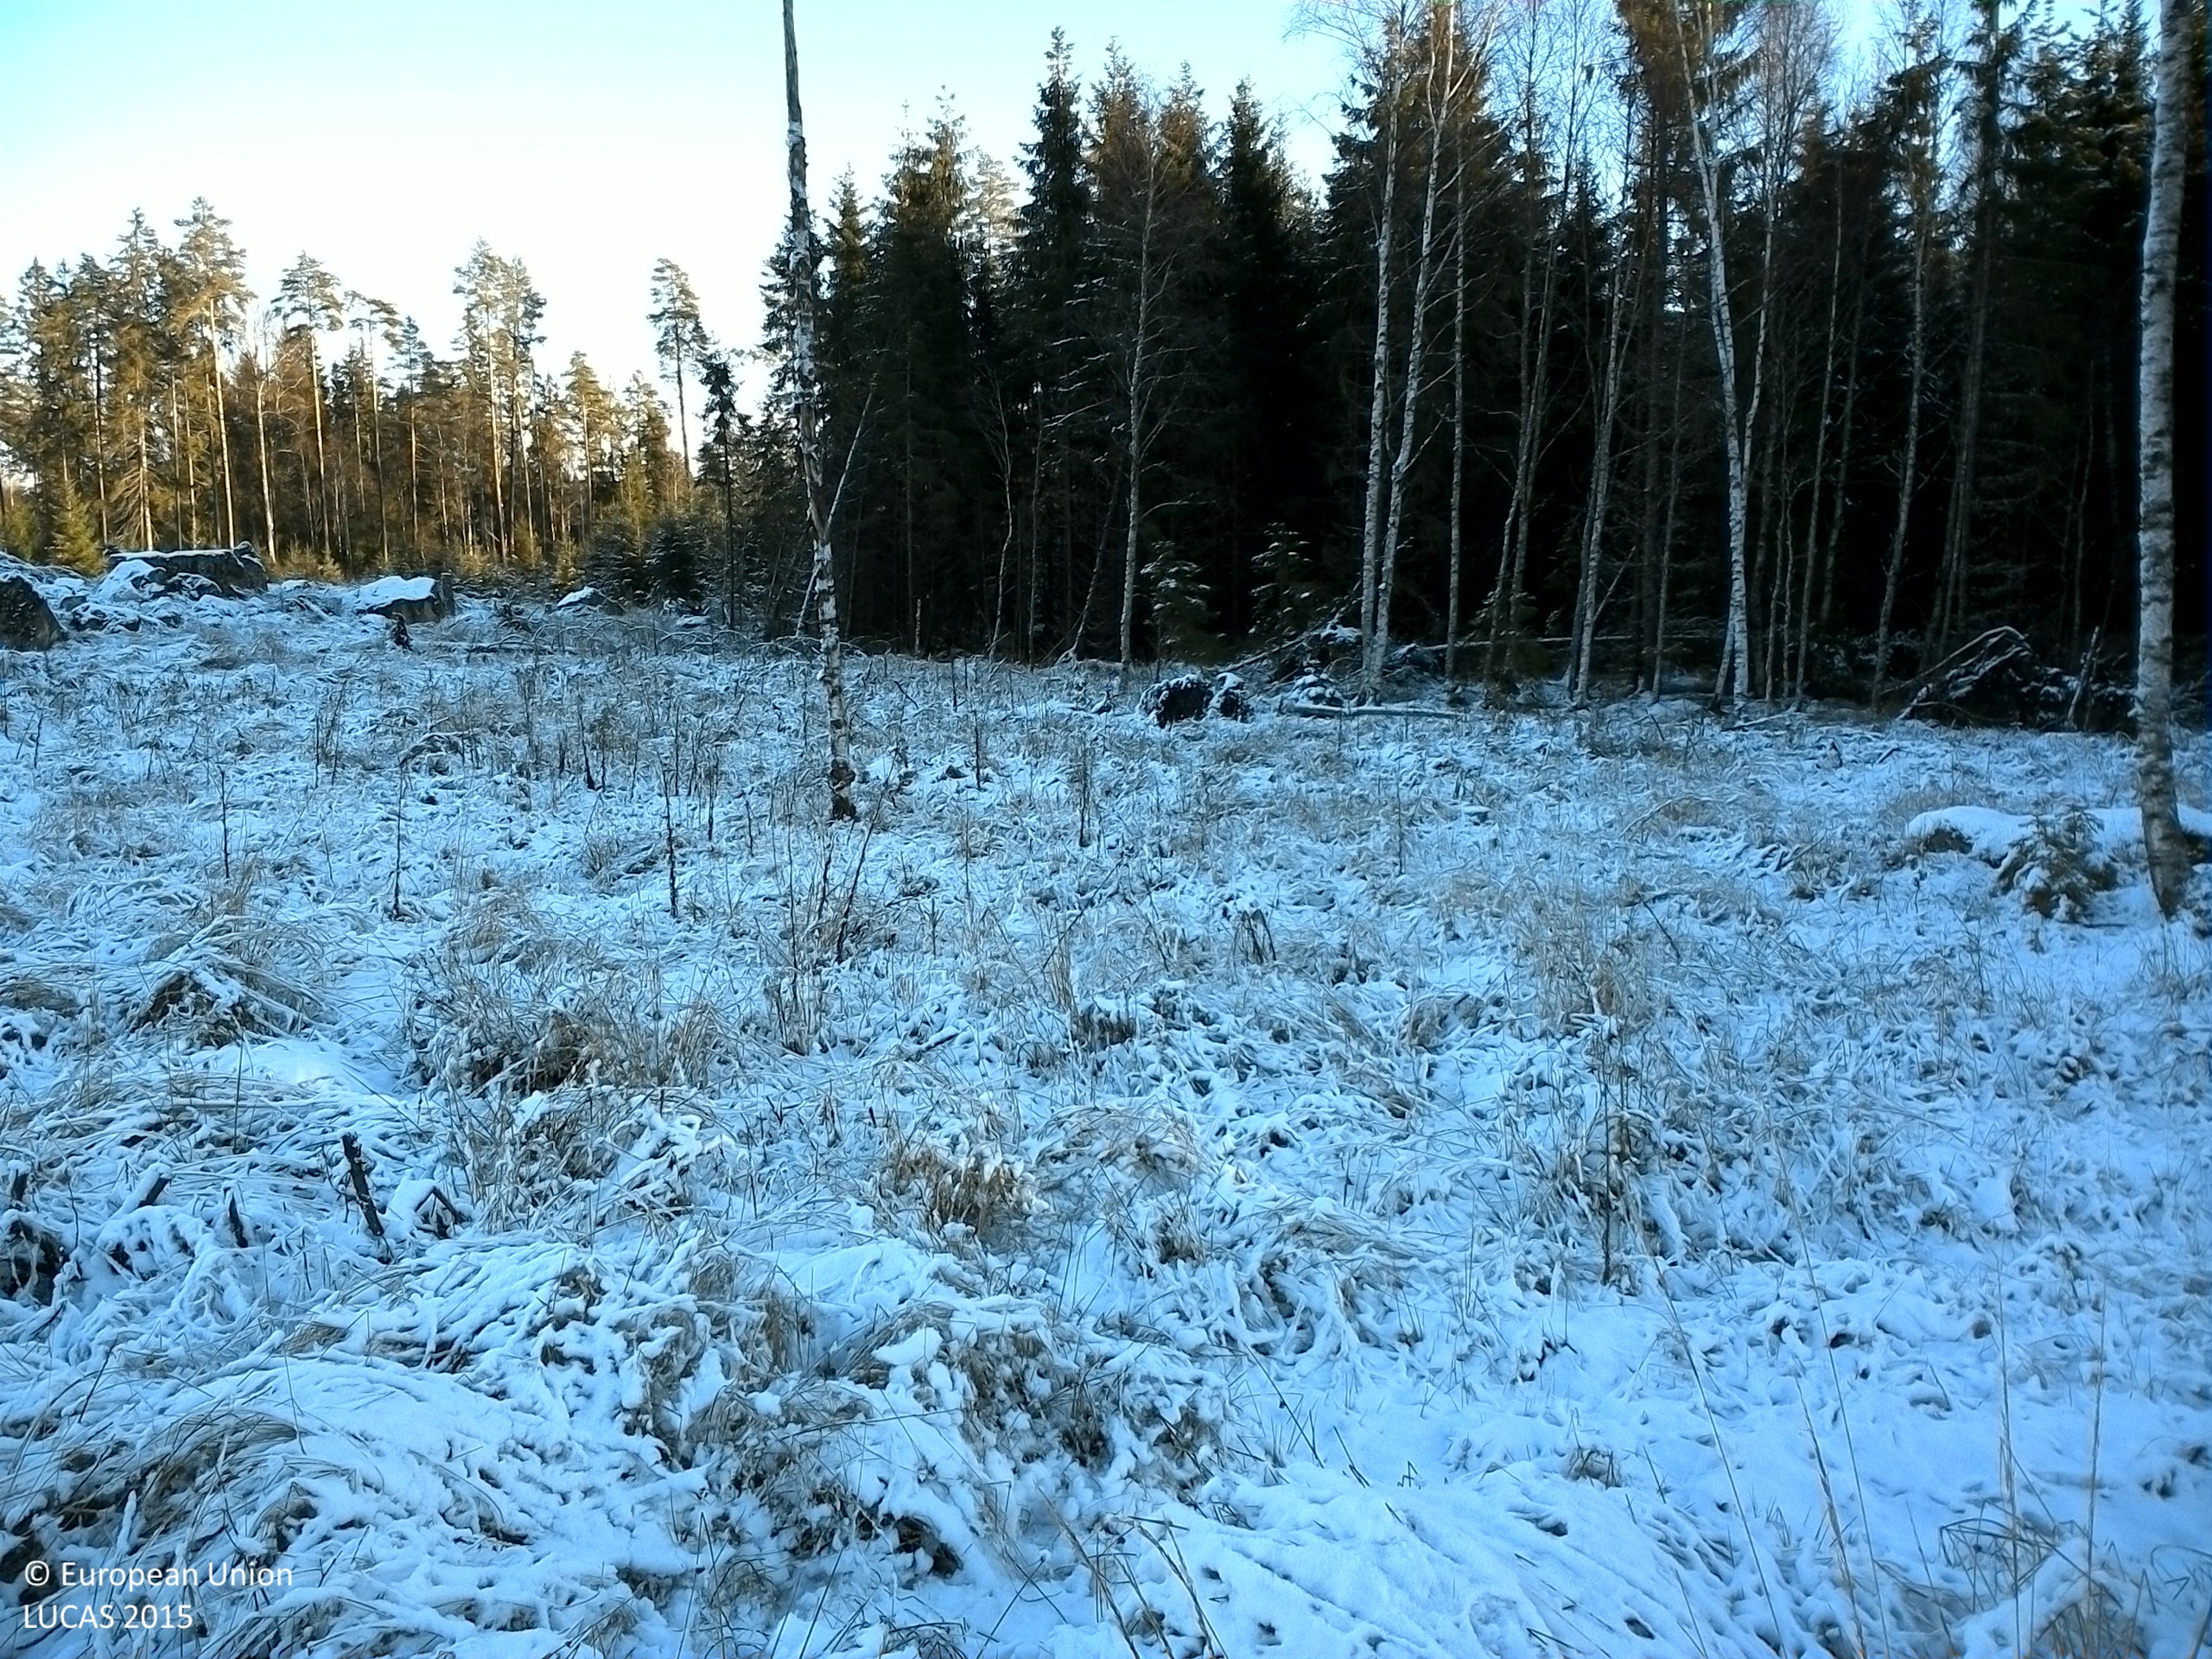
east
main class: Grassland
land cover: Grassland with sparse tree/shrub cover
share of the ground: > 75 %
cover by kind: herbaceous plants 70 %, consolidated bare surface 25 %, broadleaved forest trees 5 %
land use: Forestry
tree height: > 5 m
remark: Clear cut
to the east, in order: Grassland with sparse tree/shrub cover; Ditches and canals; Spruce dominated coniferous woodland; Rivers and streams; Spruce dominated coniferous woodland; Pine dominated coniferous woodland
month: November
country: SE
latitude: 59.6936
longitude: 16.3696
